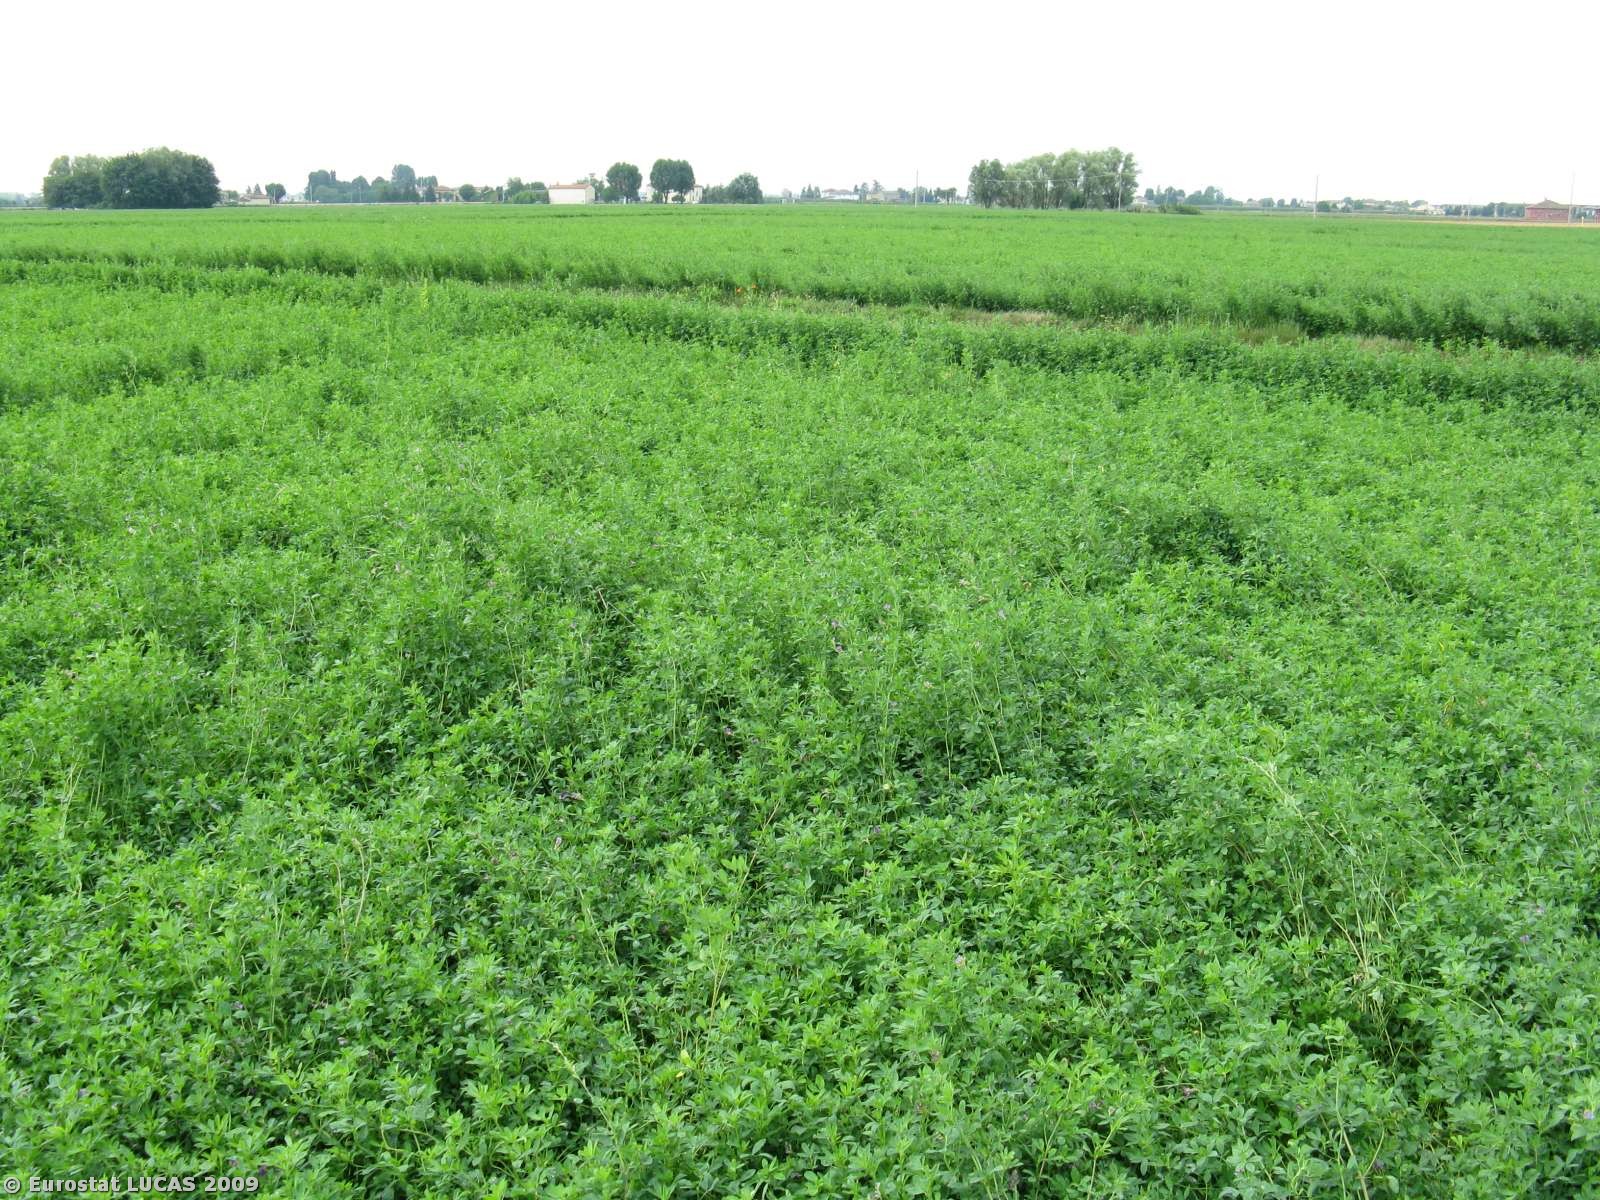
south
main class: Cropland
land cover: Lucerne
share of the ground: > 75 %
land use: Agriculture (excluding fallow land and kitchen gardens)
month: July
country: IT
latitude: 44.6261
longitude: 11.6477
